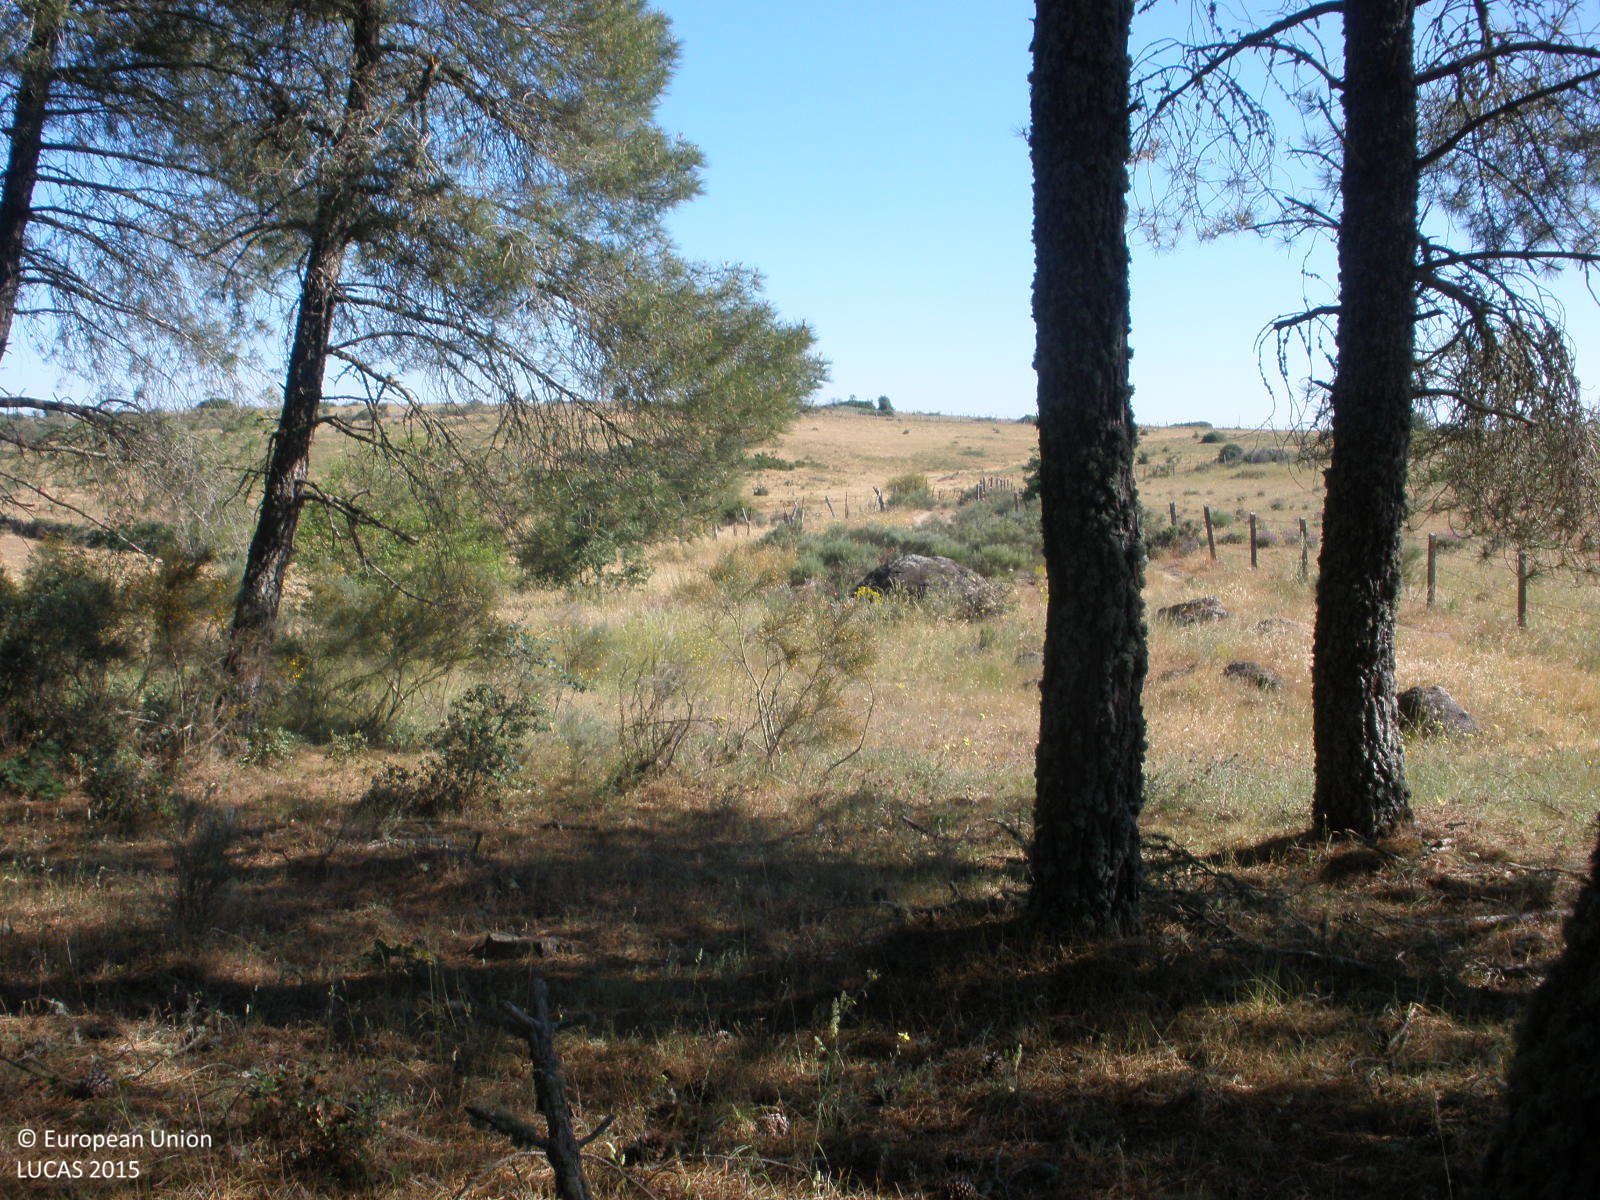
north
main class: Woodland
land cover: Pine dominated coniferous woodland
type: coniferous forest of the mediterranean region
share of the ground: > 75 %
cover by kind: coniferous forest trees 80 %, shrubs 10 %, herbaceous plants 10 %
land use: Forestry
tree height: > 5 m
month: June
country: ES
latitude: 40.4101
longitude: -6.6941
